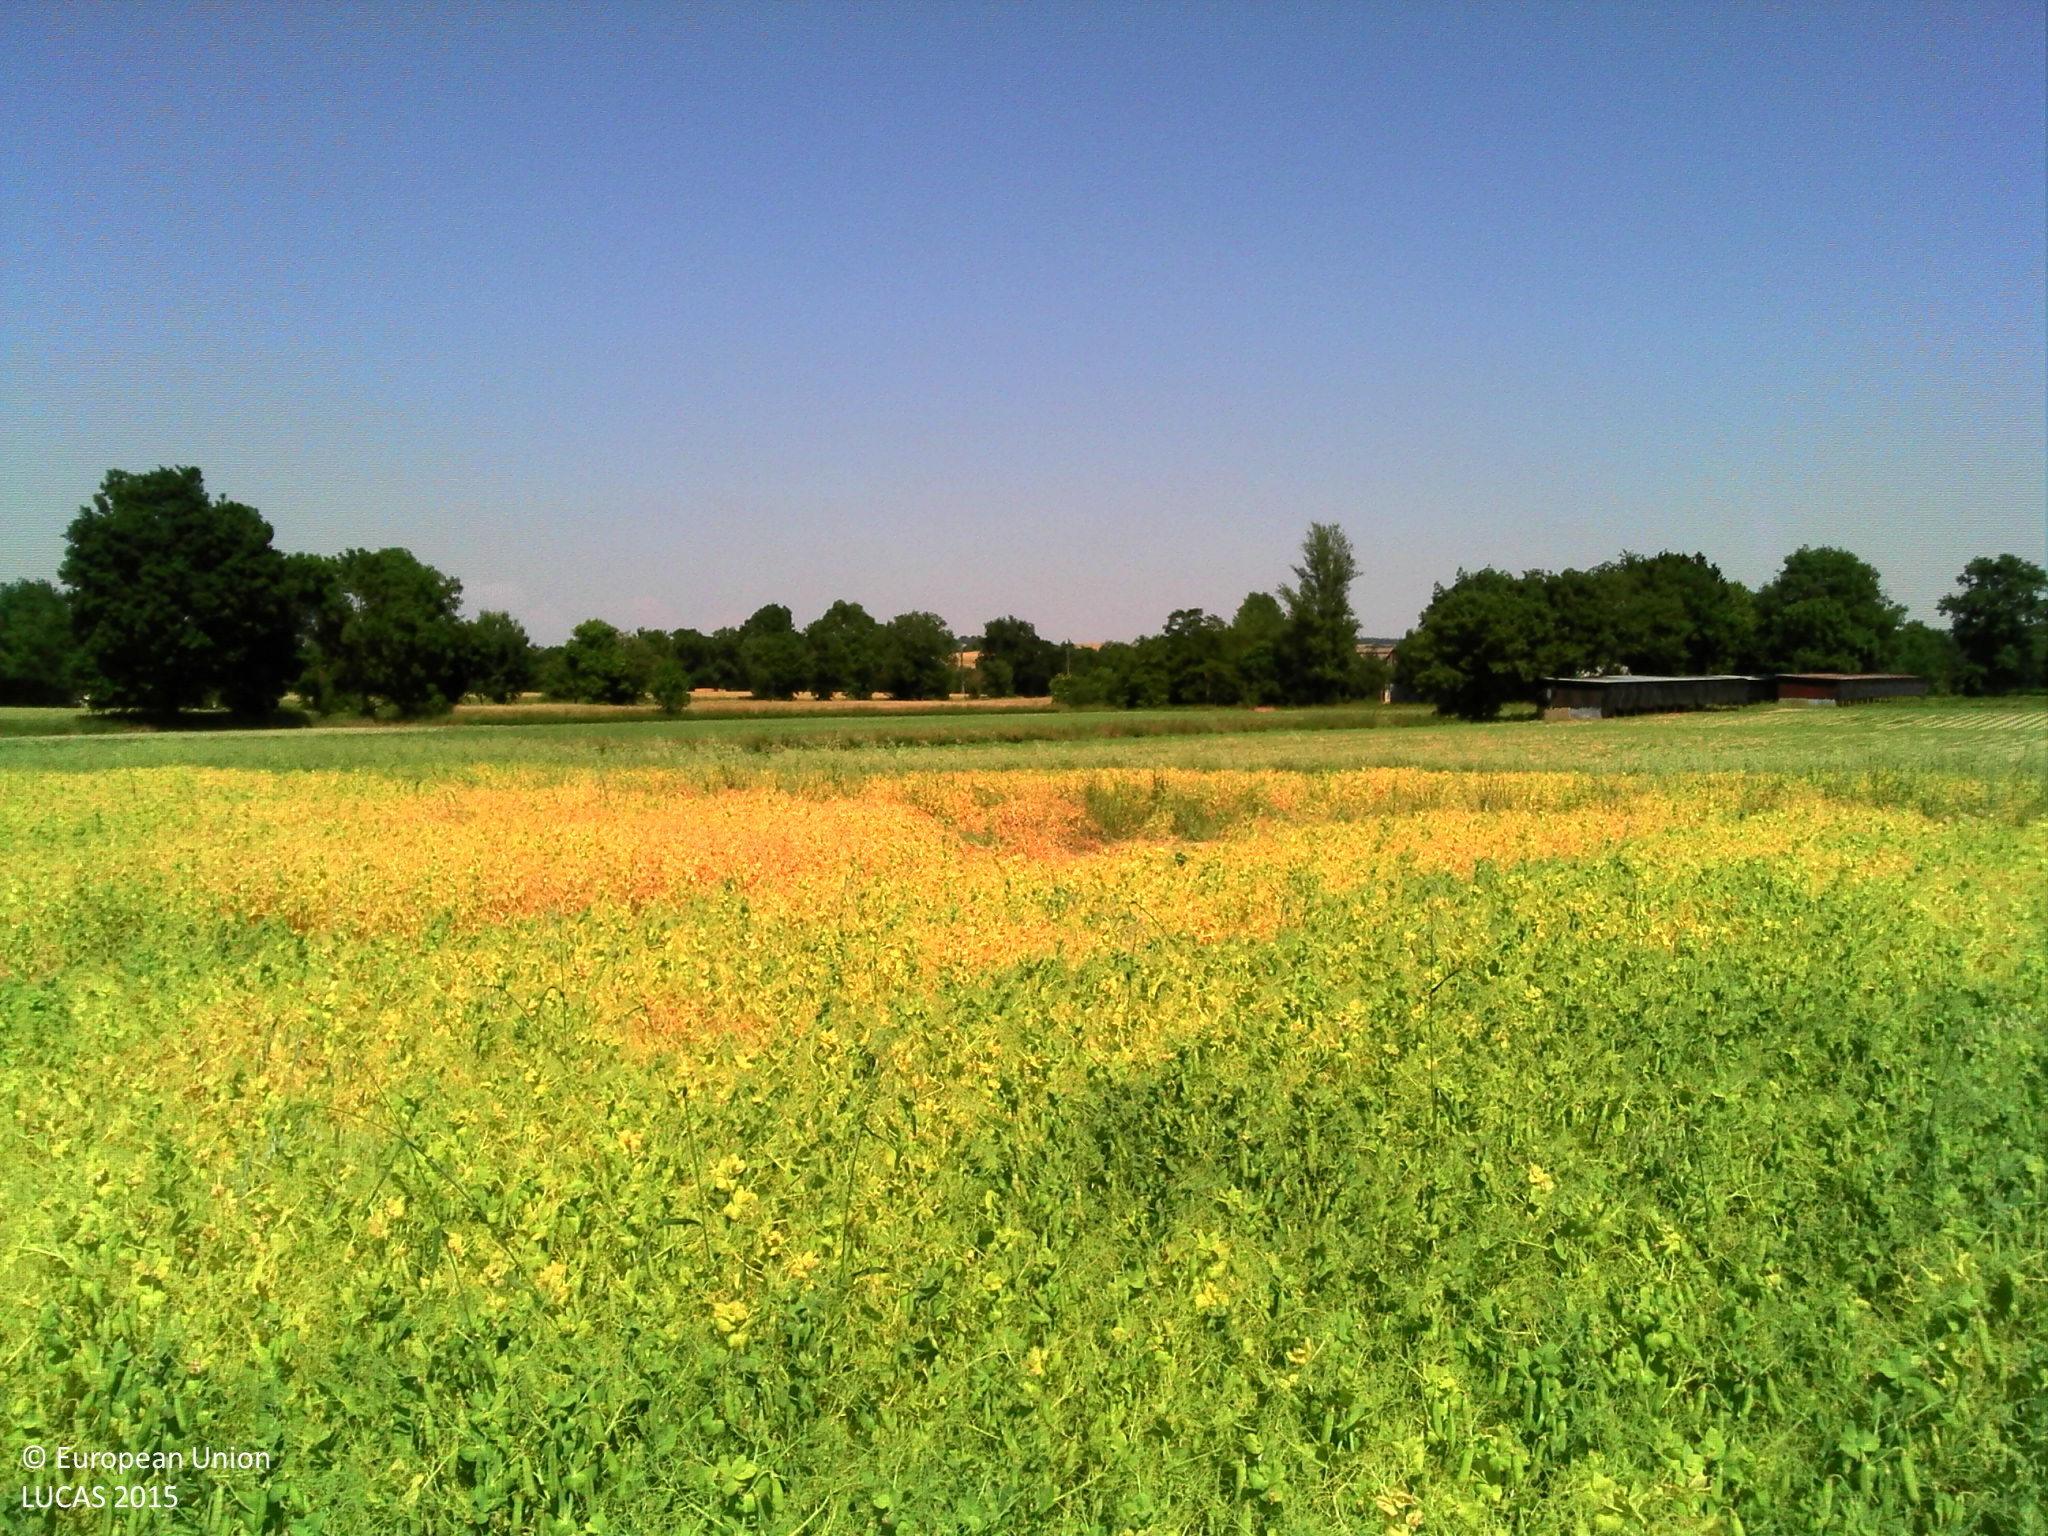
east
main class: Cropland
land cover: Dry pulses
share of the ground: > 75 %
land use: Agriculture (excluding fallow land and kitchen gardens)
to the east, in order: Dry pulses; Grass margins; Sunflower; Grass margins; Ditches and canals; Grass margins; Sunflower; Single bushes/trees; Sunflower; Grass margins; Ditches and canals; Broadleaved woodland; Artificial constructions in urban areas; Other fresh vegetables
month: June
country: FR
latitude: 43.8196
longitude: 0.6597
